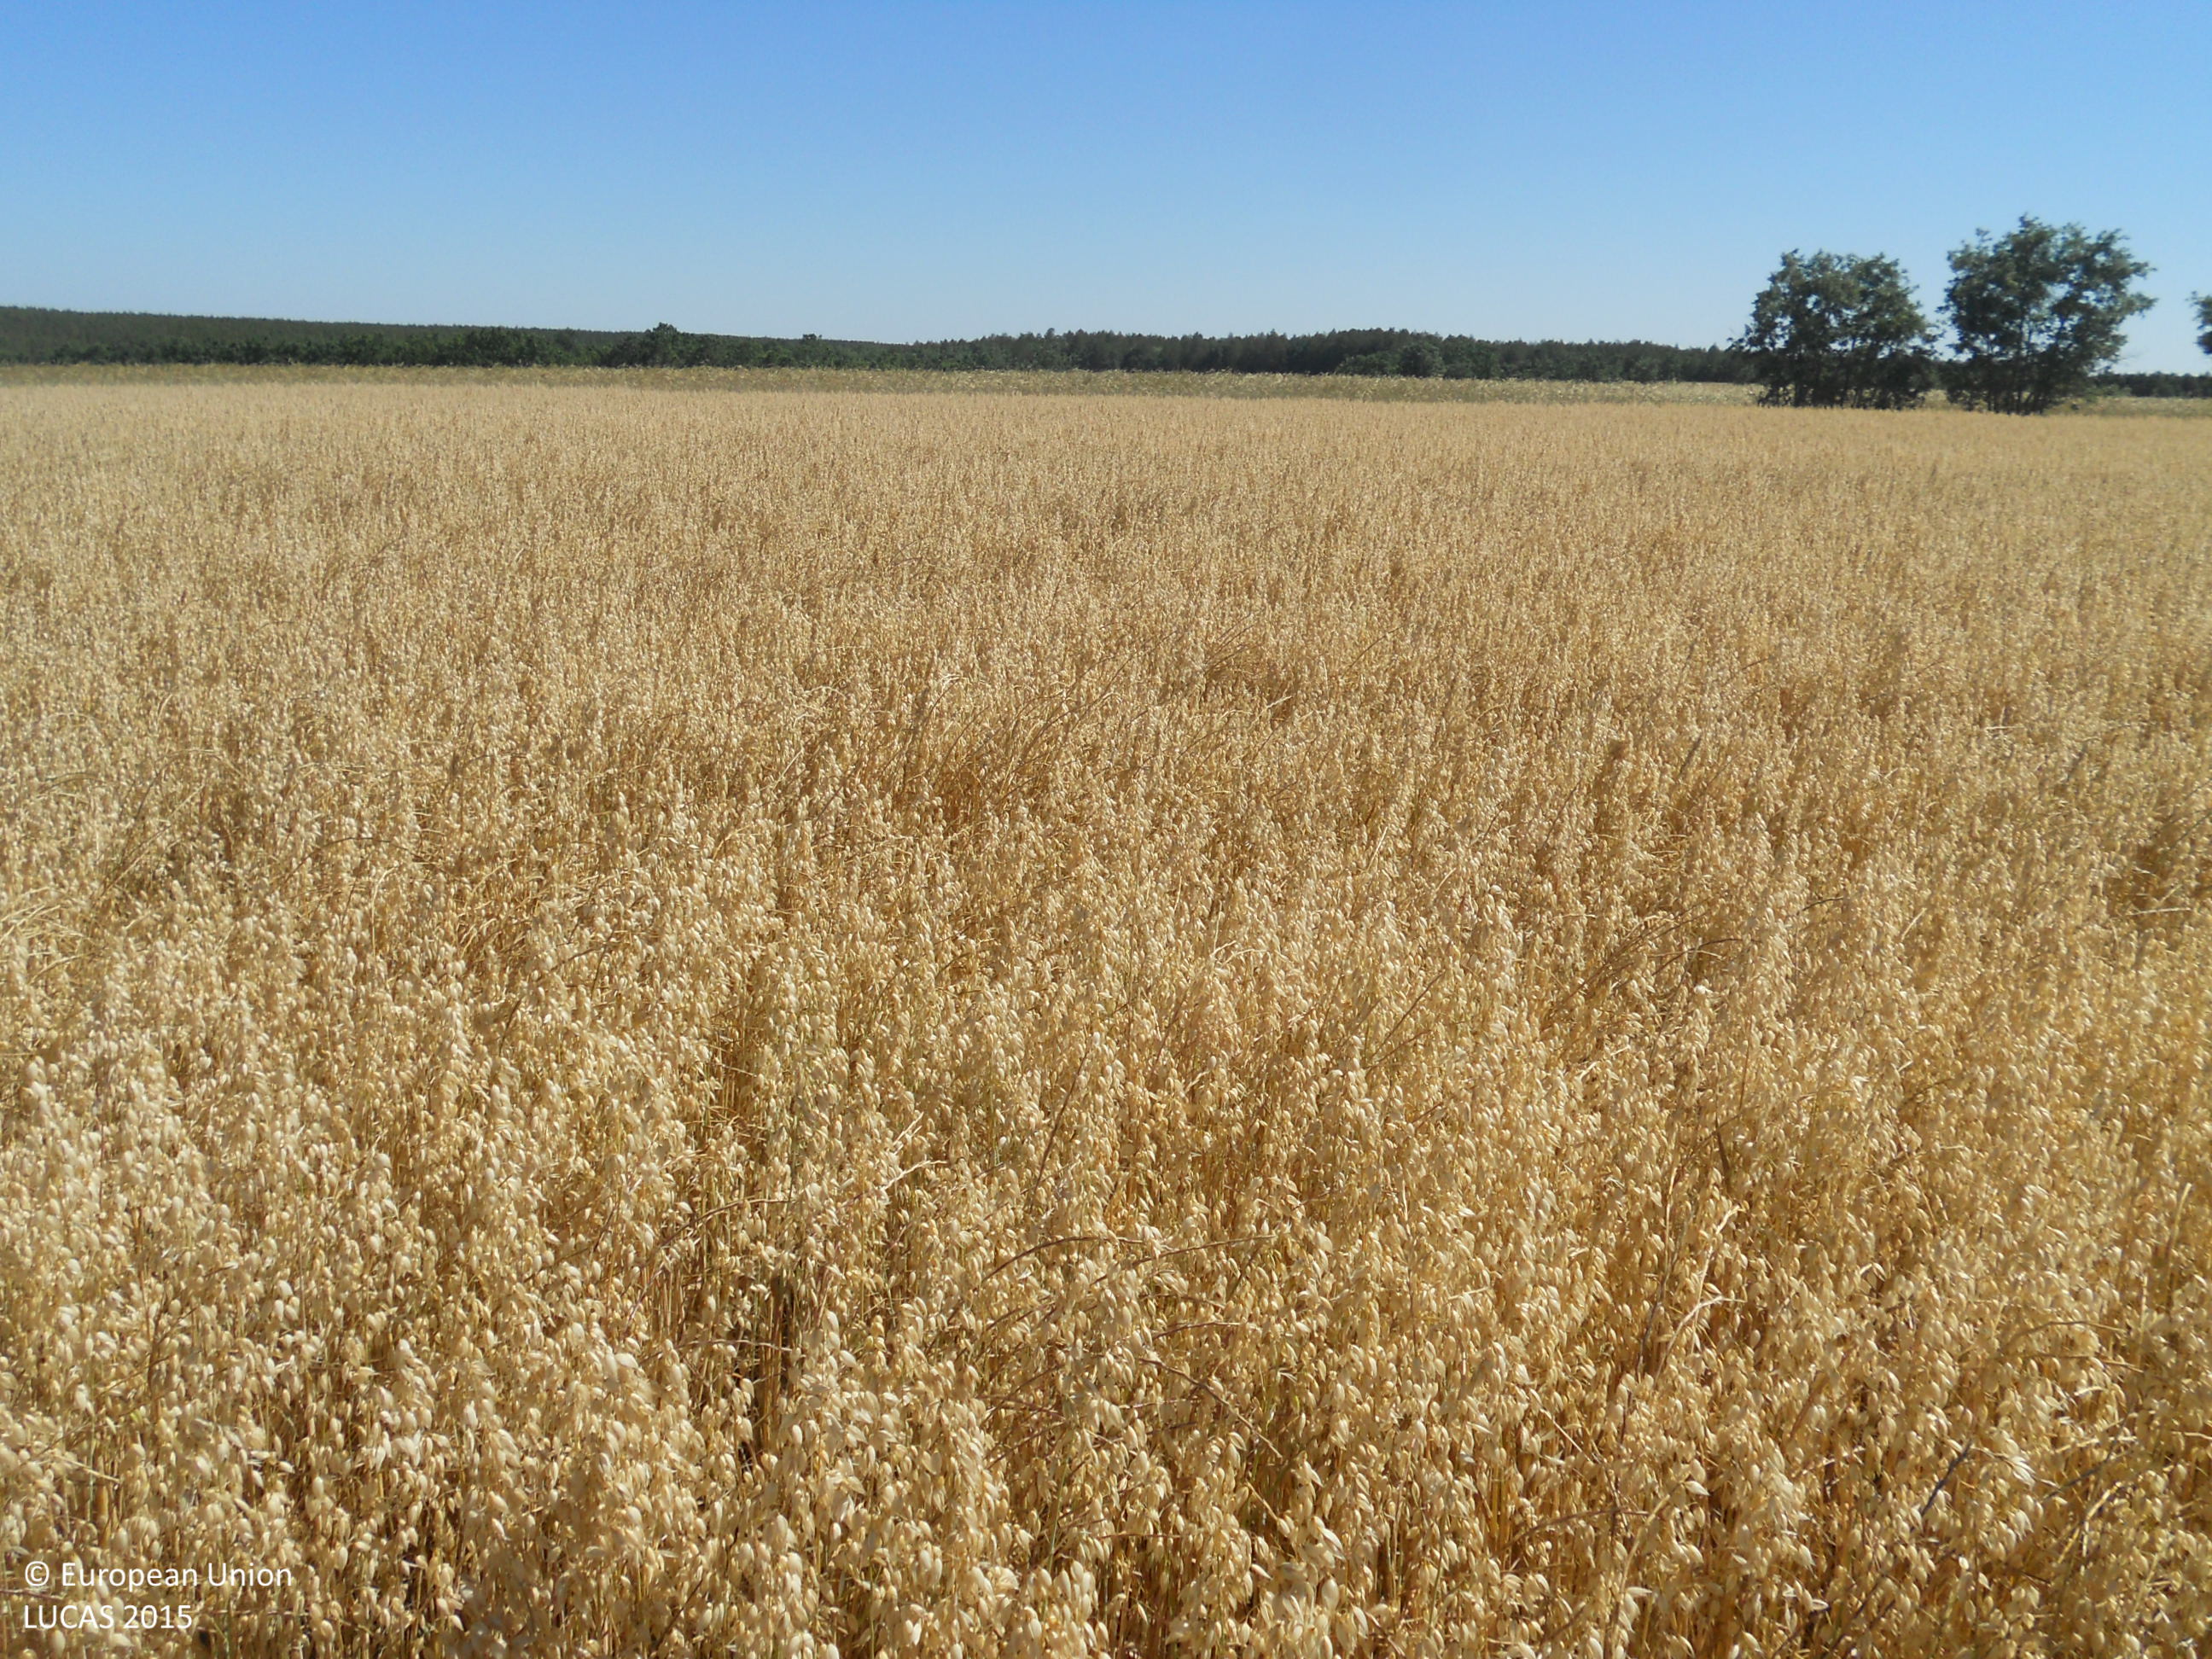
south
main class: Cropland
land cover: Oats
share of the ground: > 75 %
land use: Agriculture (excluding fallow land and kitchen gardens)
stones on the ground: > 50 %
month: June
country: ES
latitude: 42.4110
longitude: -4.8692
